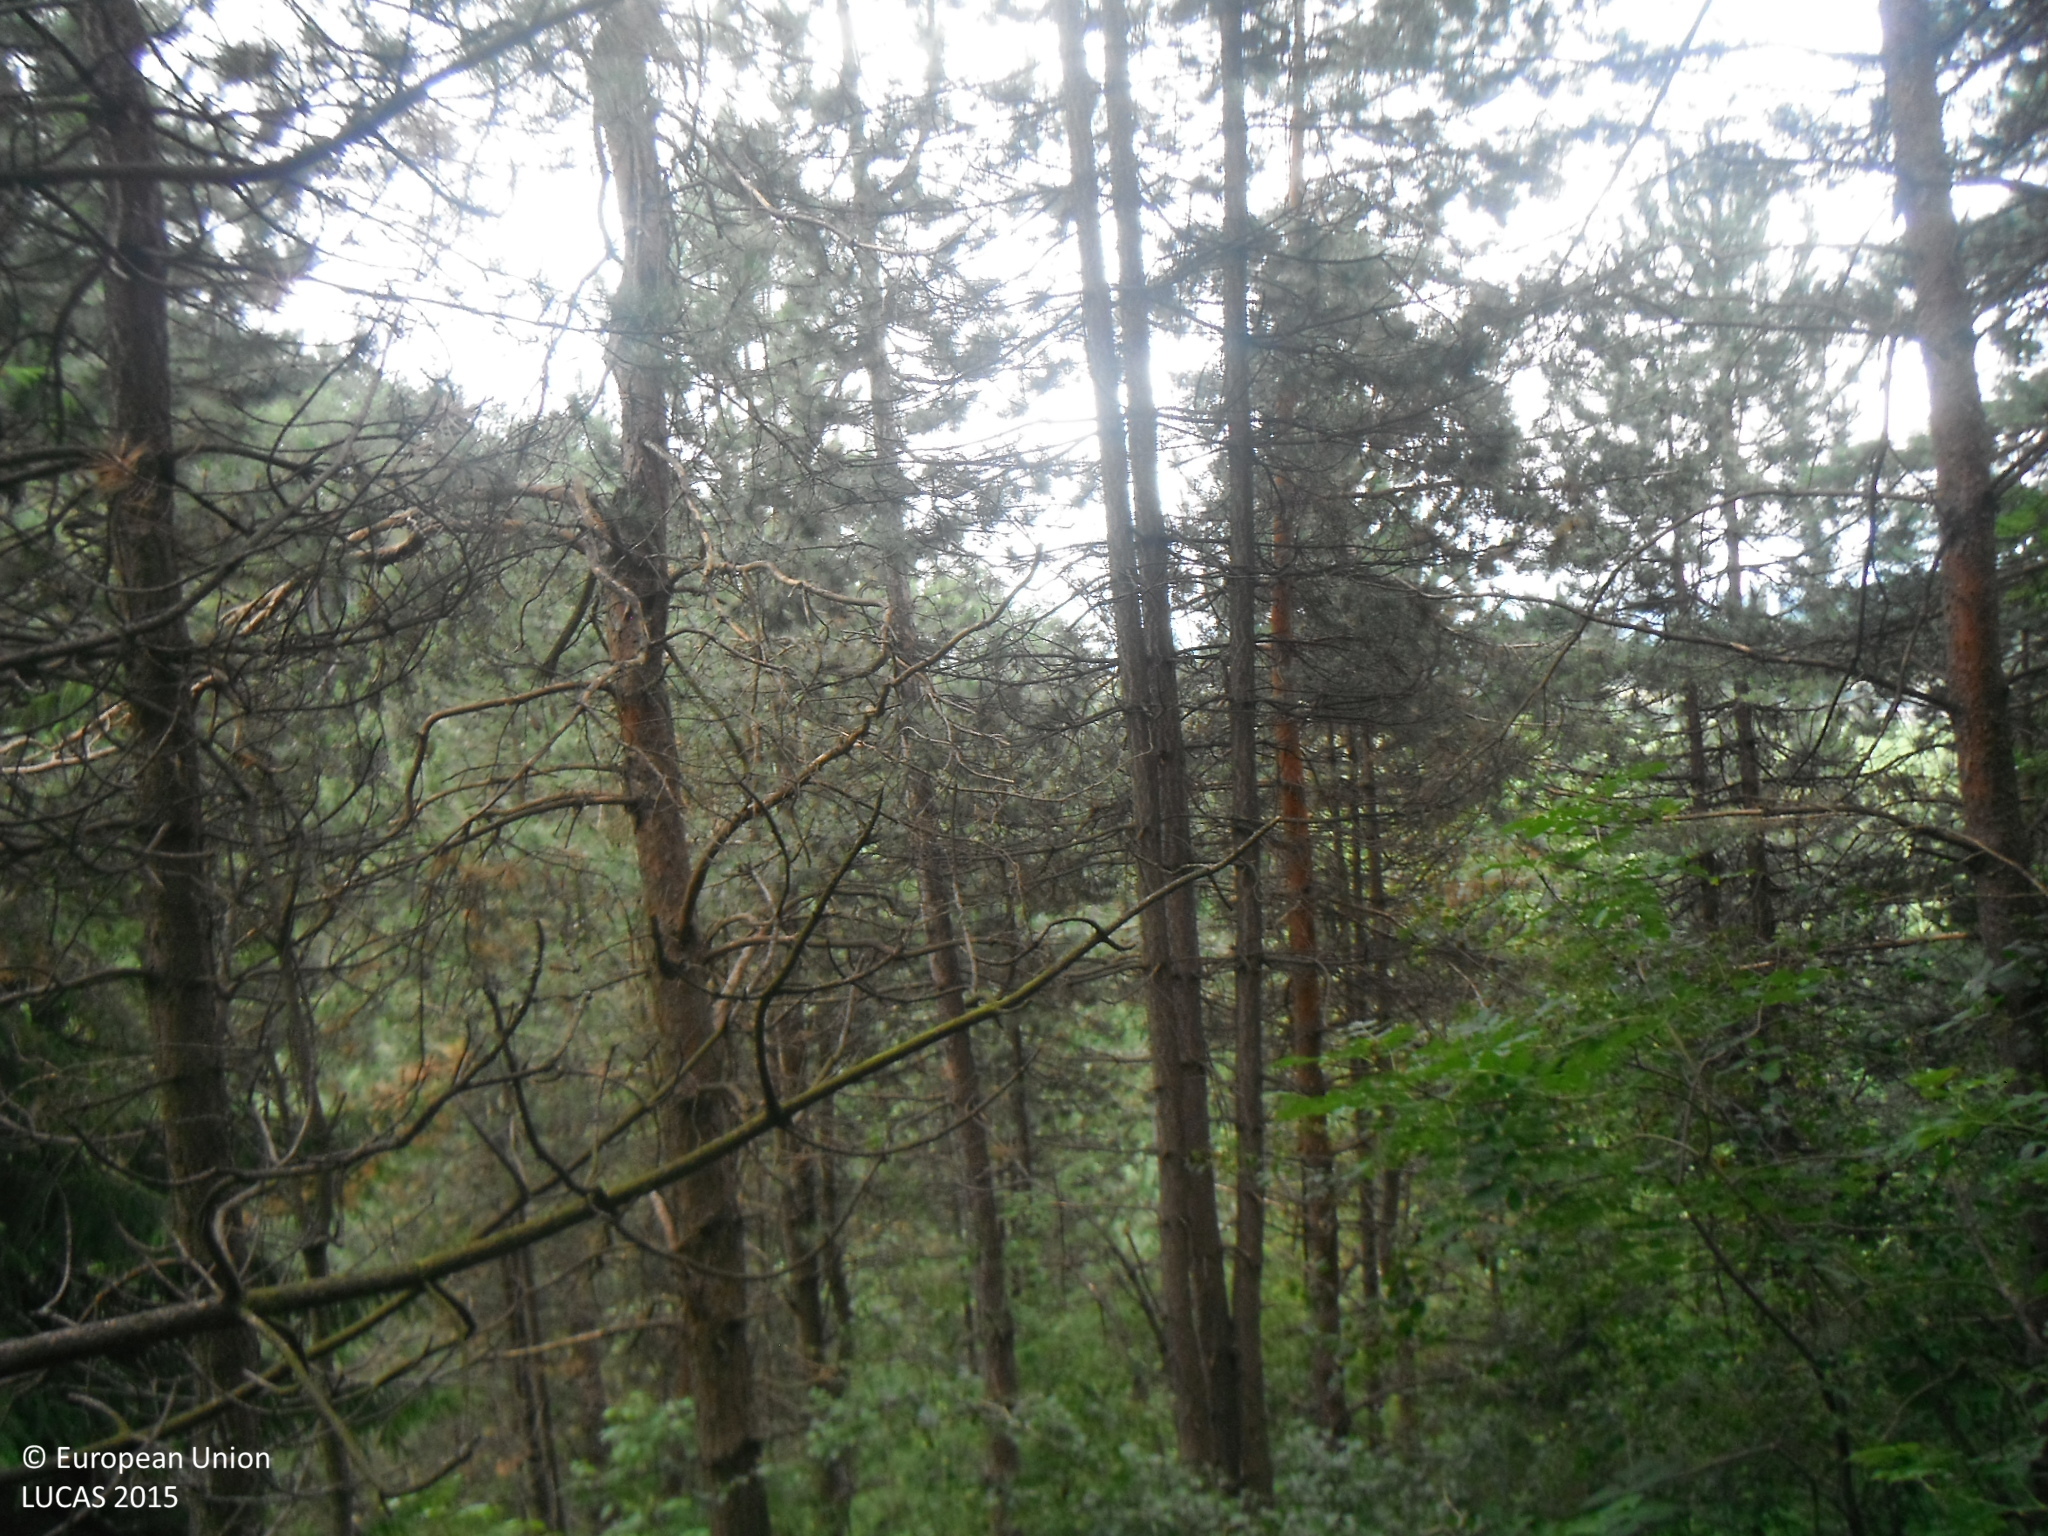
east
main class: Woodland
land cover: Pine dominated coniferous woodland
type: alpine coniferous forest
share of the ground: > 75 %
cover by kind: coniferous forest trees 75 %, herbaceous plants 15 %, shrubs 10 %
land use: Forestry
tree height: > 5 m
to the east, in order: Pine dominated coniferous woodland; Shrubland with sparse tree cover; Pine dominated mixed woodland; Spruce dominated coniferous woodland; Spruce dominated mixed woodland
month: July
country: SK
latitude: 49.2403
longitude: 18.4097
